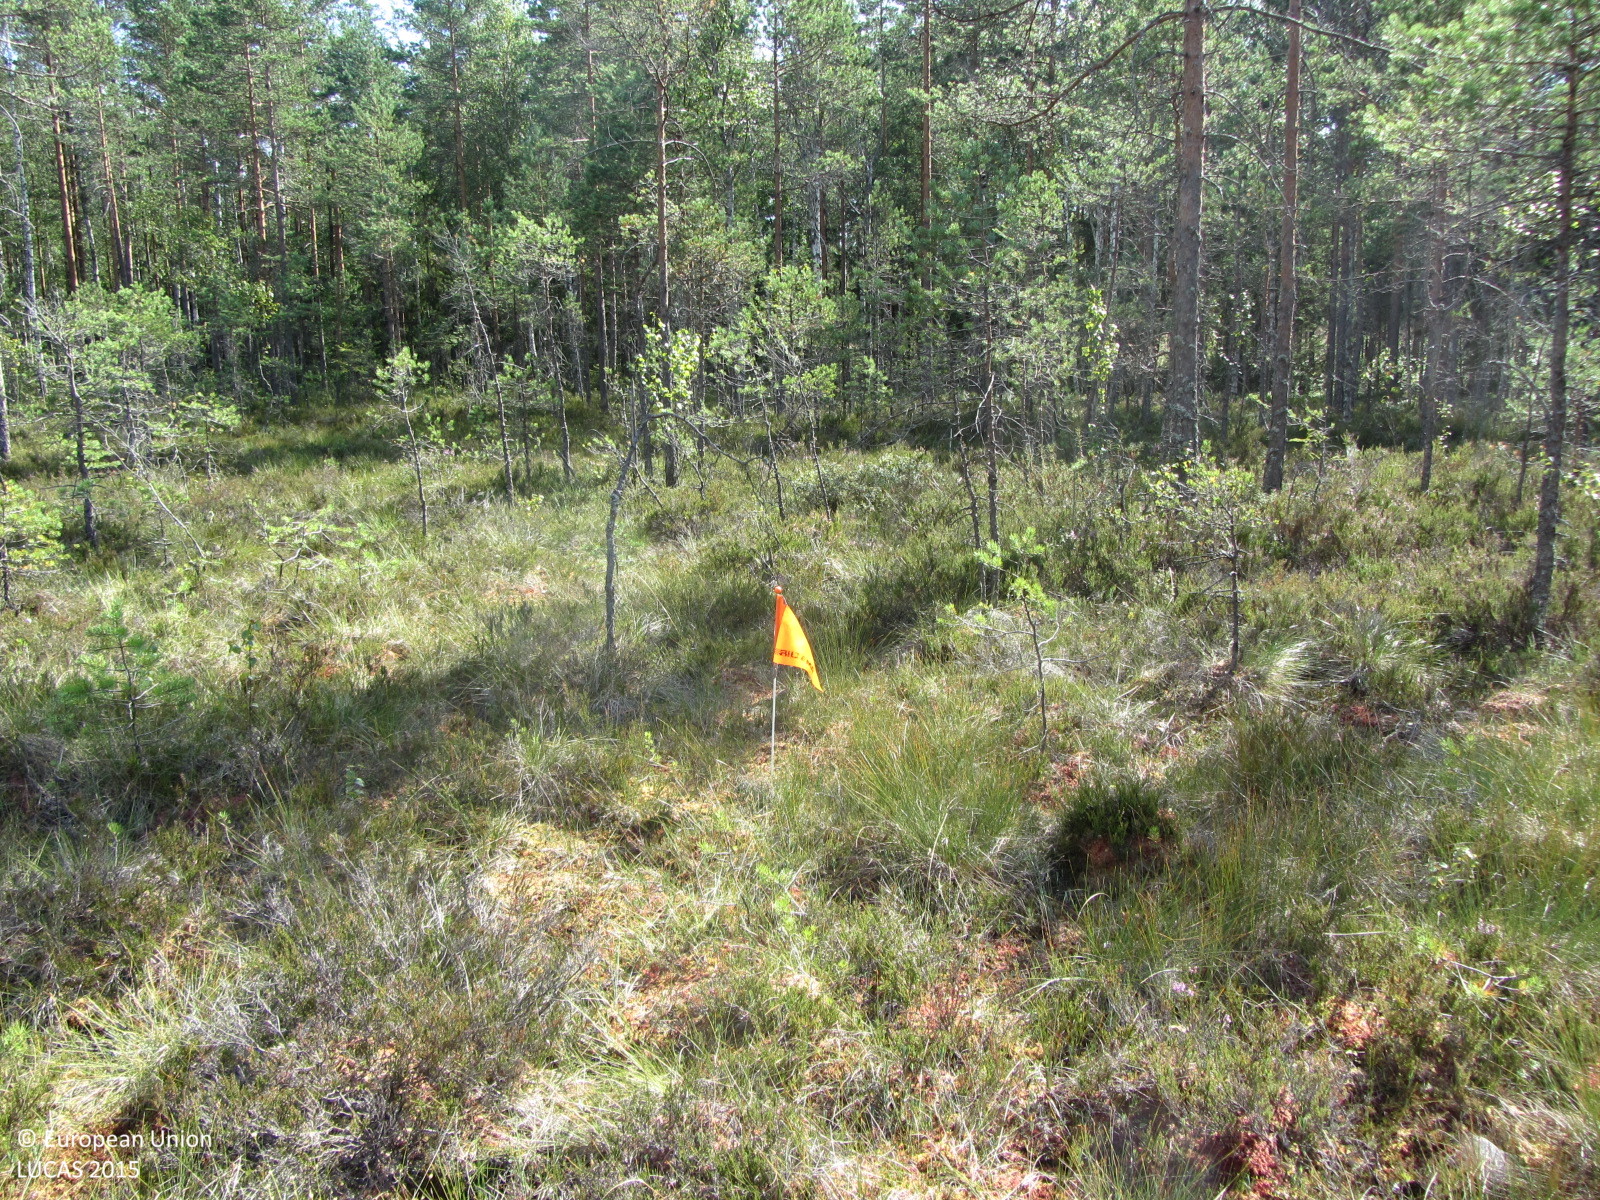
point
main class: Woodland
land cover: Pine dominated mixed woodland
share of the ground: 10 - 25 %
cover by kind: shrubs 60 %, herbaceous plants 15 %, coniferous forest trees 10 %, lichens and mosses 10 %, broadleaved forest trees 5 %
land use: Semi-natural and natural areas not in use
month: August
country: FI
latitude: 60.4515
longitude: 23.4102
